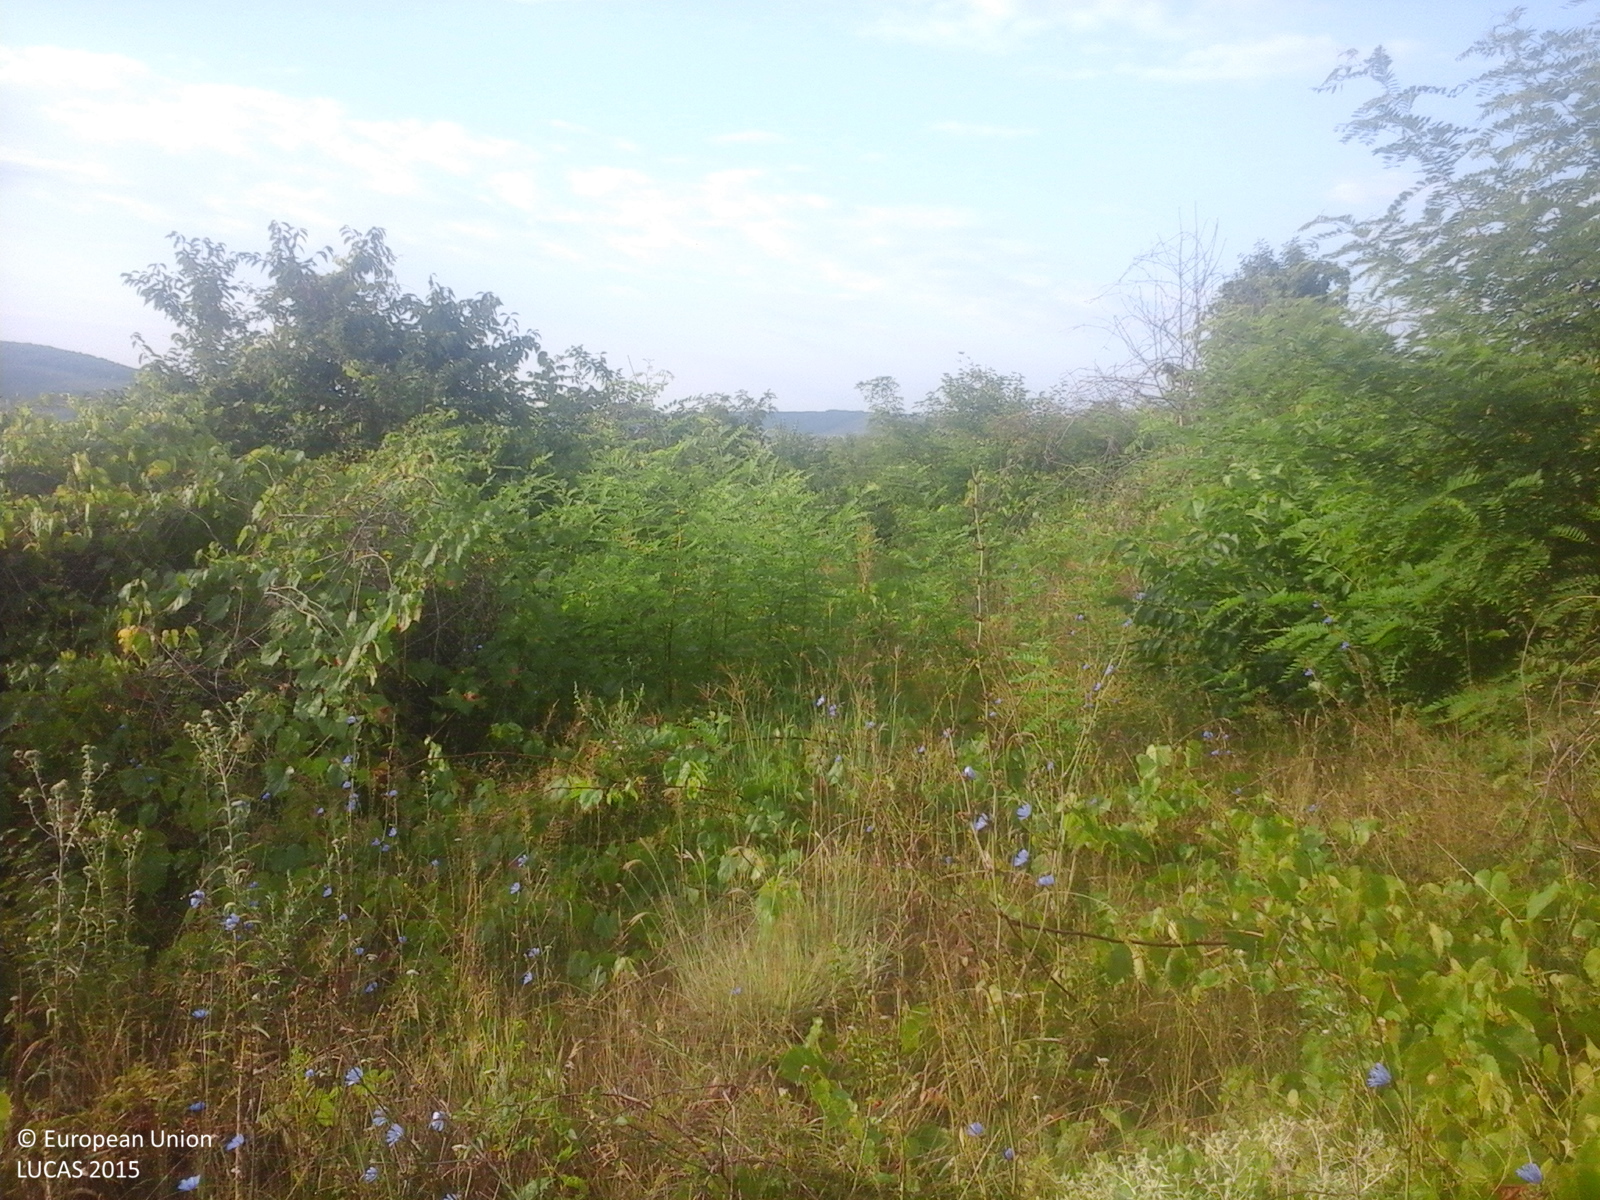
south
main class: Woodland
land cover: Broadleaved woodland
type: exotic forest
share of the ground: > 75 %
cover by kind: broadleaved forest trees 100 %
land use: Semi-natural and natural areas not in use
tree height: > 5 m
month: July
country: RO
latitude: 46.5660
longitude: 27.8518
